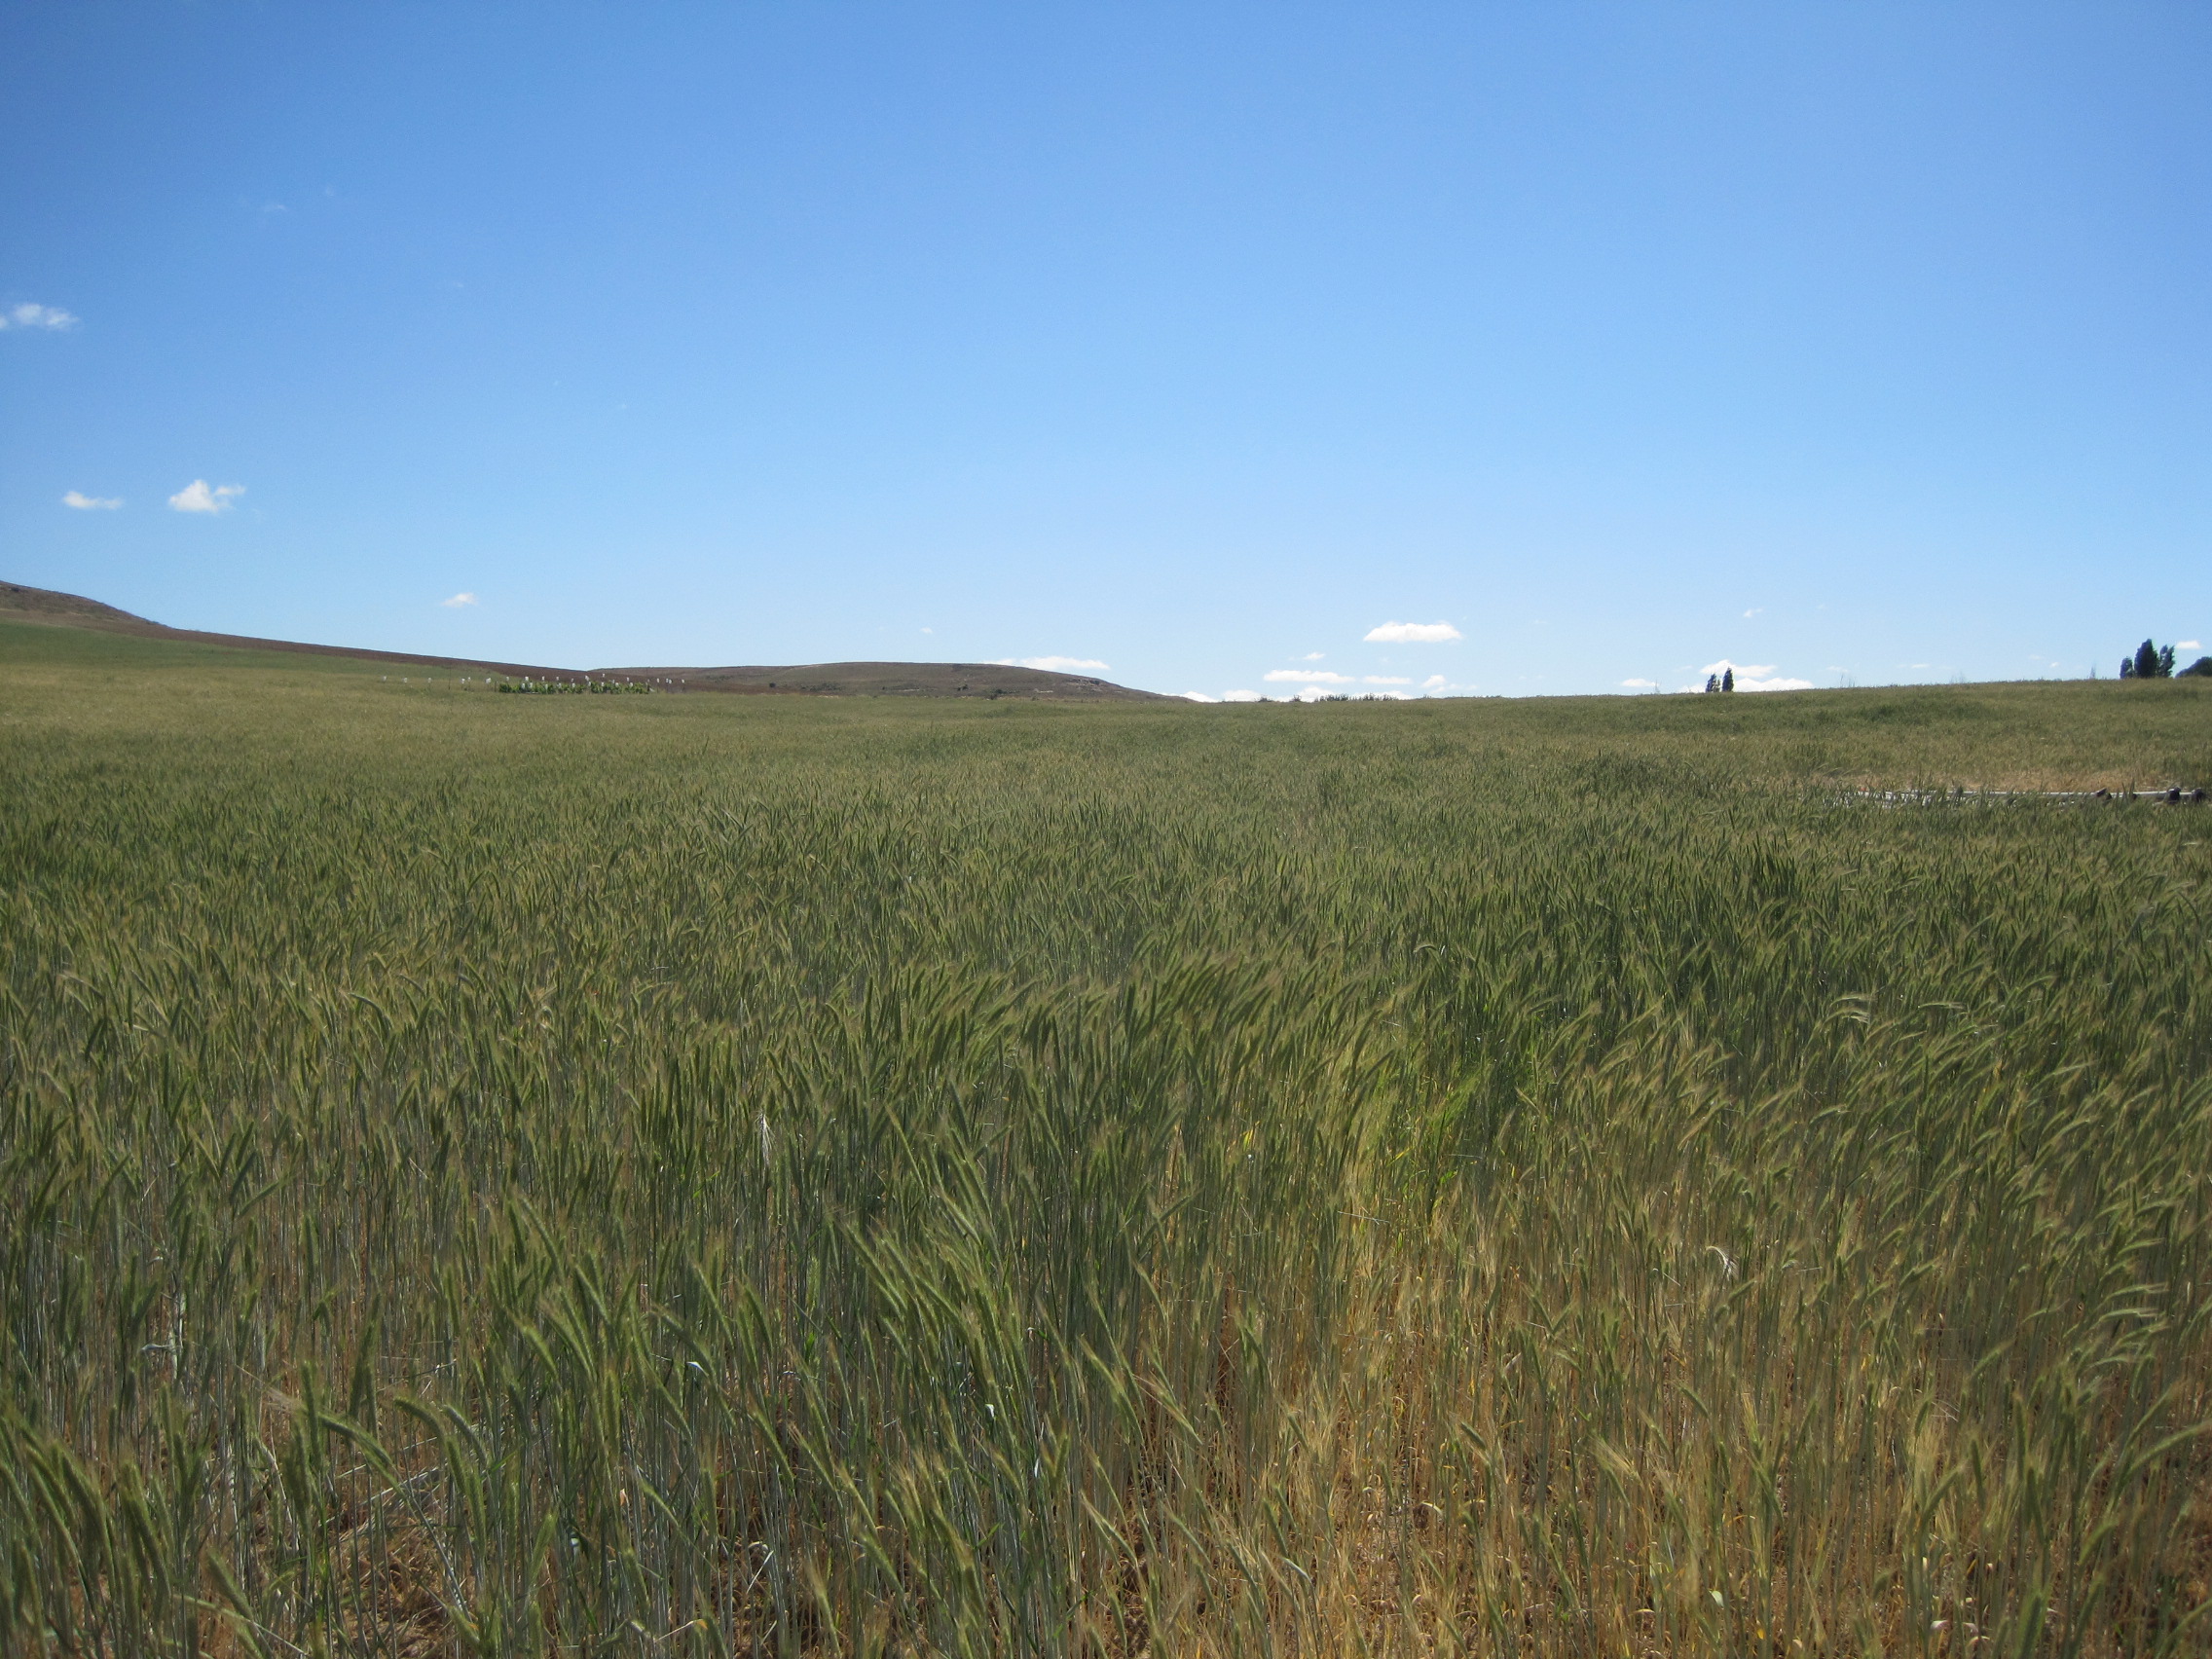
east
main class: Cropland
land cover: Rye
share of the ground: > 75 %
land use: Agriculture (excluding fallow land and kitchen gardens)
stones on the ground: < 10 %
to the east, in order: Rye; Grass margins; Other bare soil
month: May
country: ES
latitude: 41.1725
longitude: -5.2944
